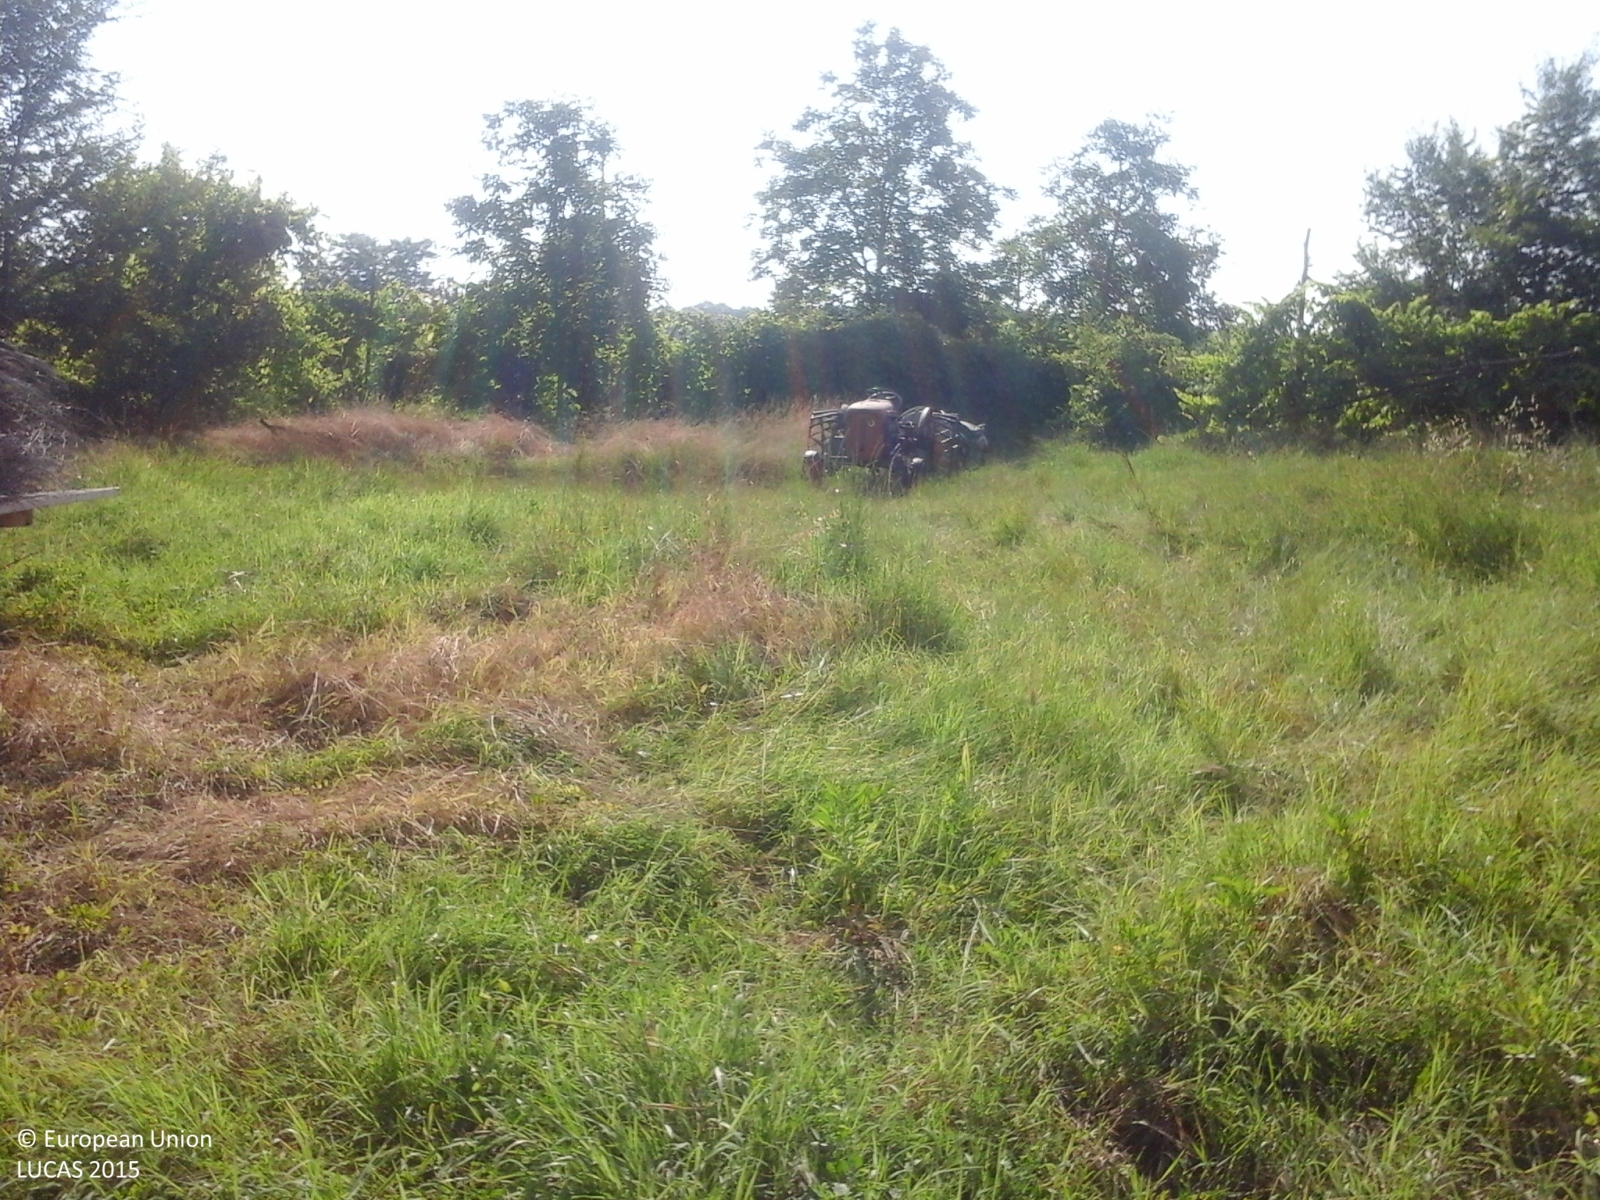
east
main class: Cropland
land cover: Common wheat
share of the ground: > 75 %
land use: Agriculture (excluding fallow land and kitchen gardens)
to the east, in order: Common wheat; Grassland without tree/shrub cover; Vineyards; Grassland without tree/shrub cover; Arable land (only in case pi); Ditches and canals; Arable land (only in case pi); Ditches and canals; Arable land (only in case pi); Ditches and canals; Arable land (only in case pi); Permanent crops (only in case pi); Tracks; Permanent crops (only in case pi)
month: June
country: IT
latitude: 44.8875
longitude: 10.9224
